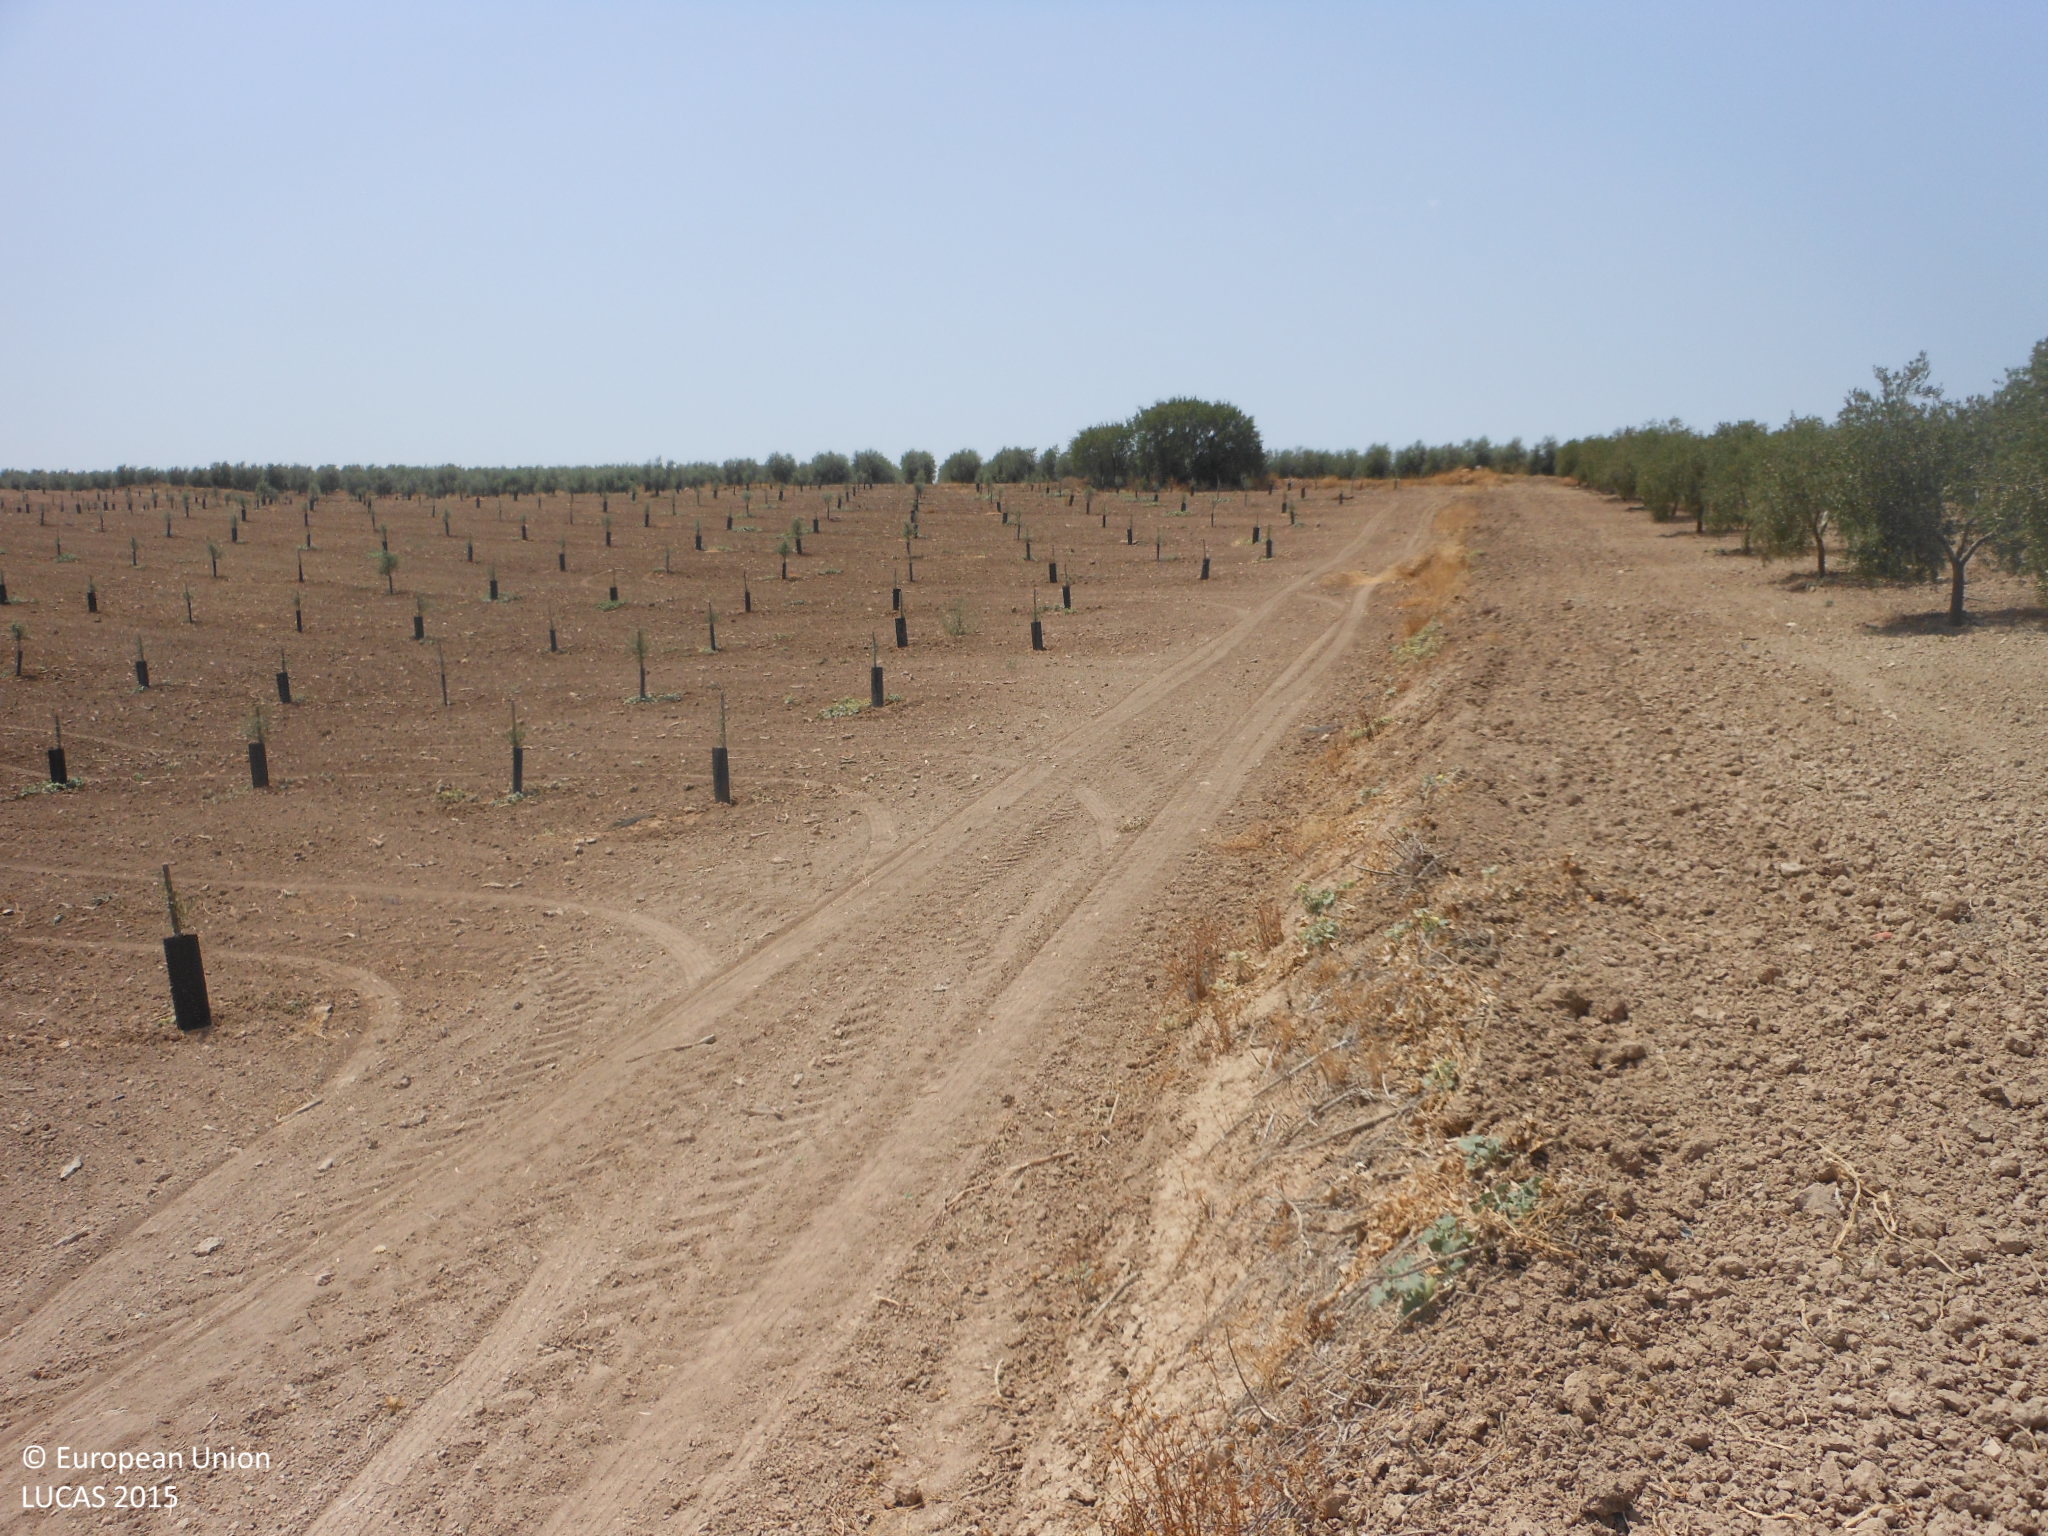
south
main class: Cropland
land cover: Olive groves
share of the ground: 25 - 50 %
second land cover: Other bare soil
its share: > 75 %
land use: Agriculture (excluding fallow land and kitchen gardens)
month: July
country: ES
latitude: 37.3866
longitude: -5.0652
